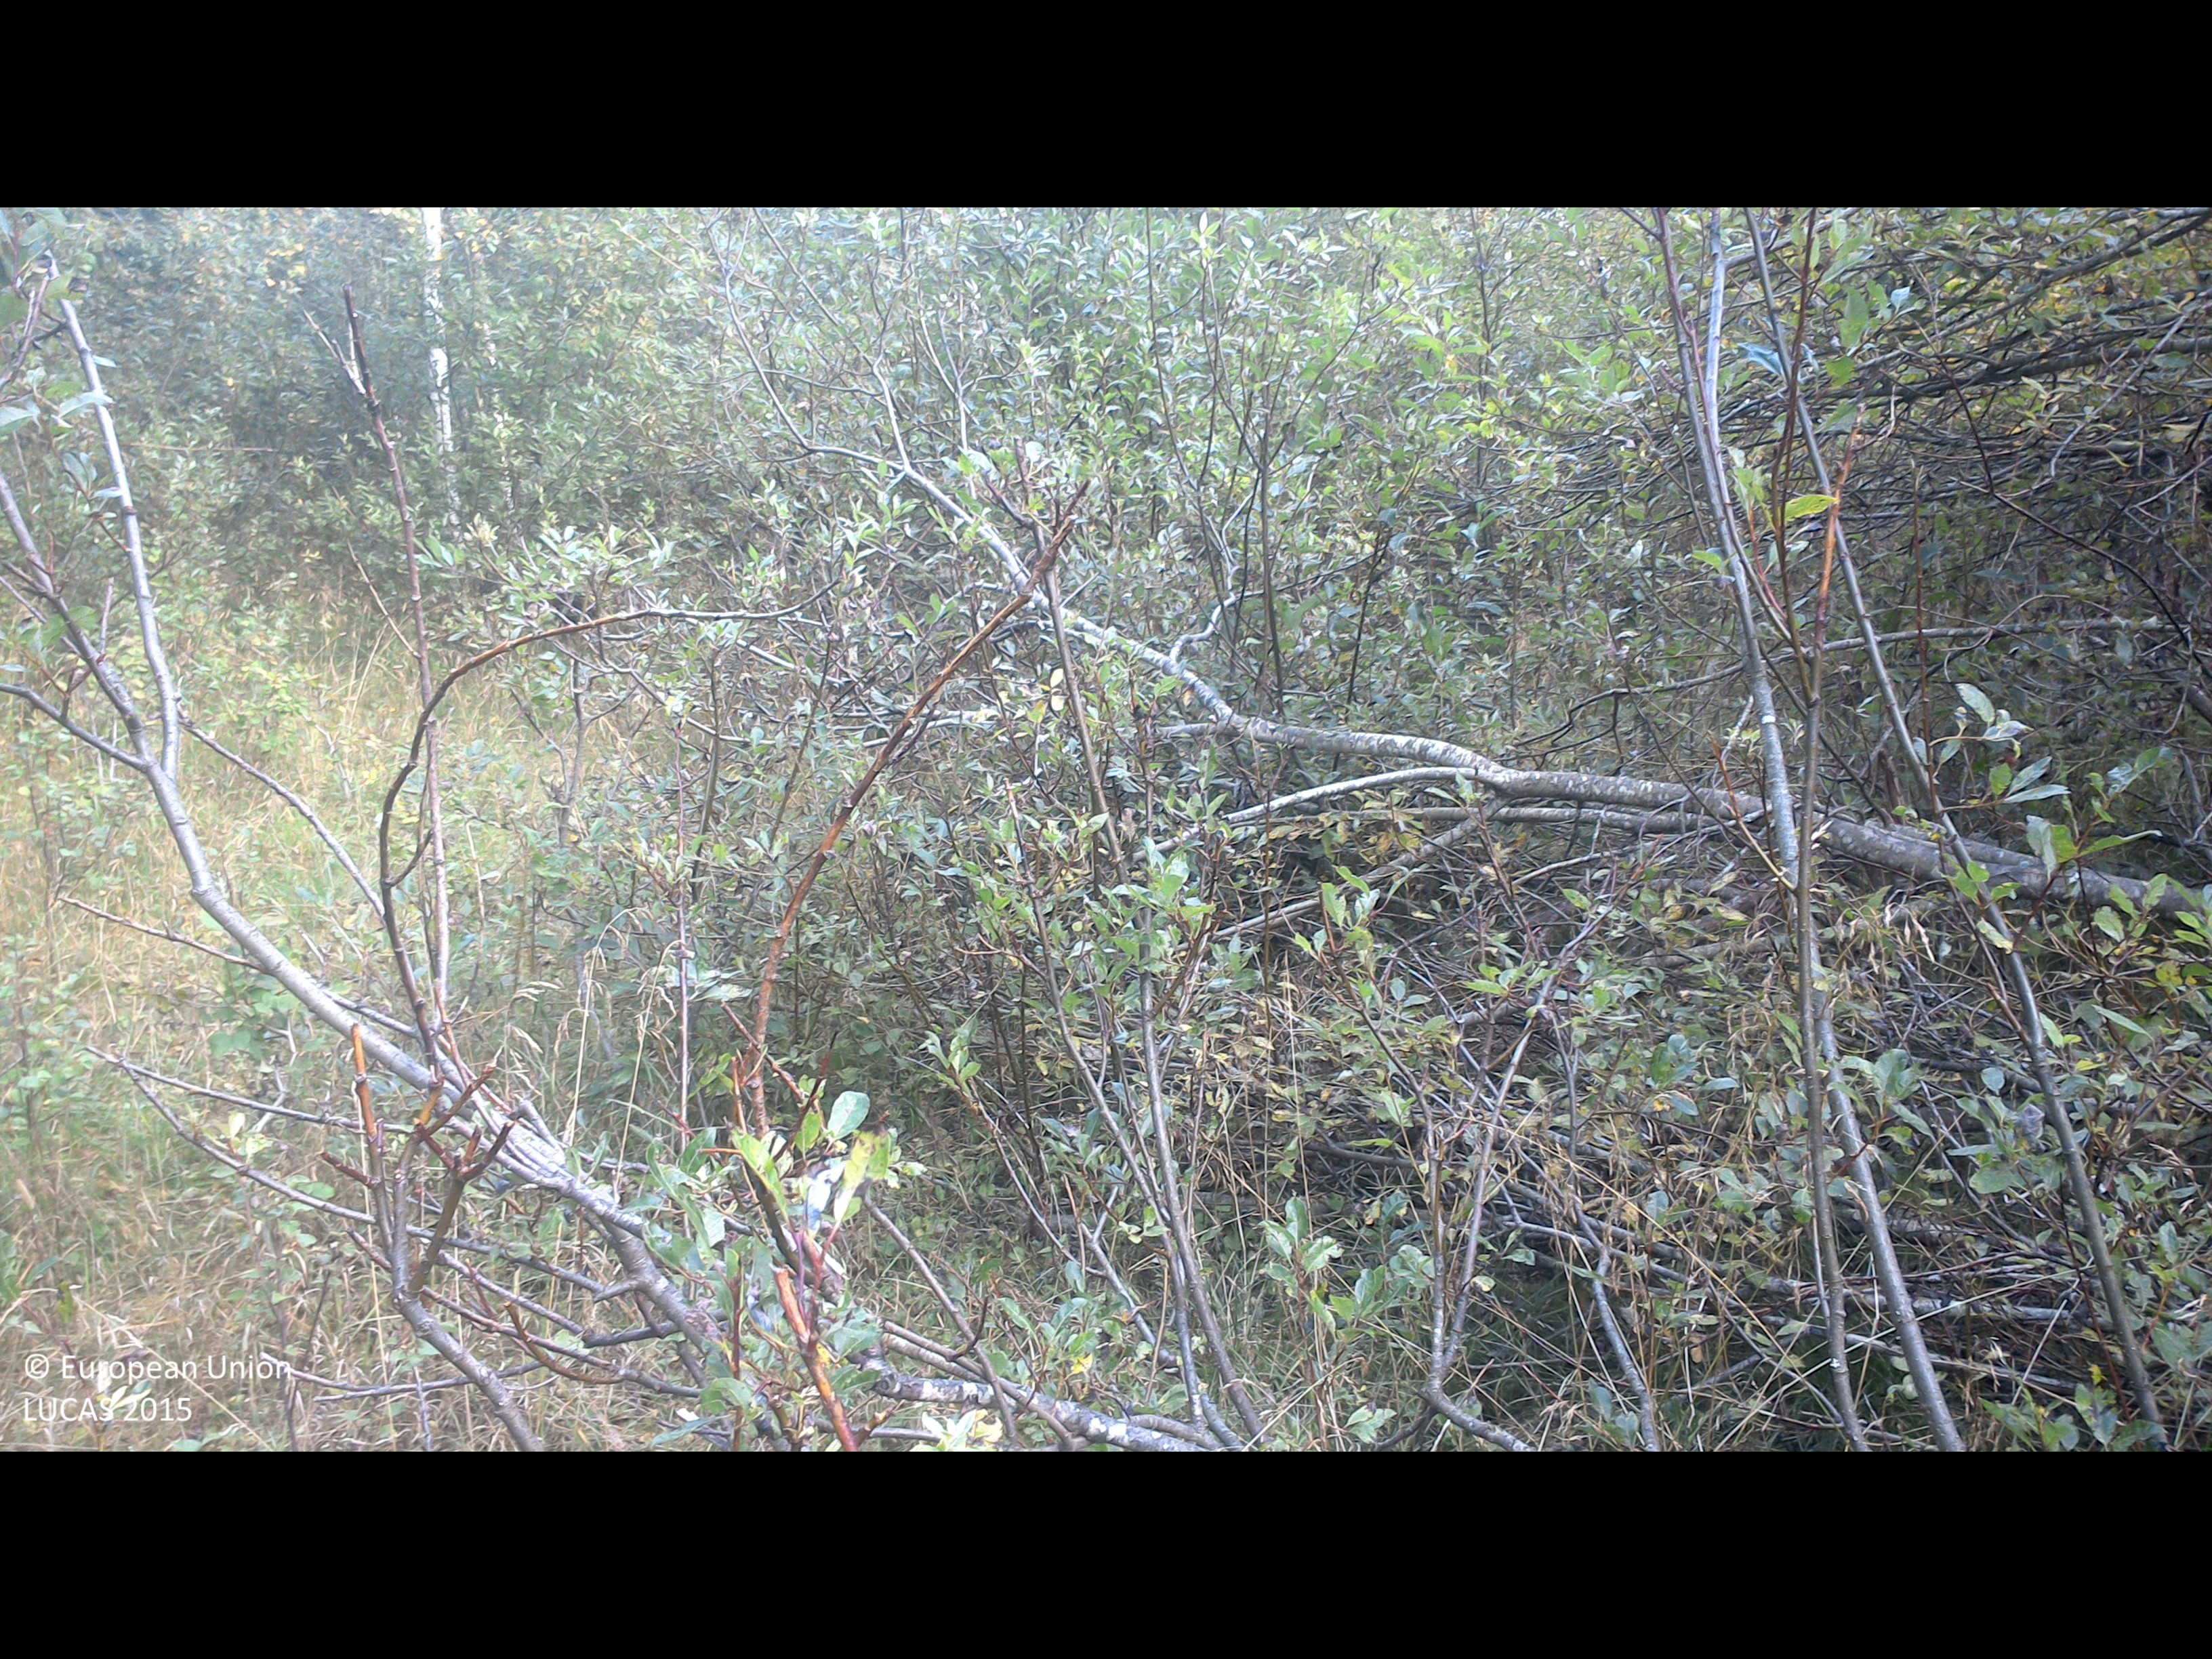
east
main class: Woodland
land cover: Broadleaved woodland
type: boreal forest
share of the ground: 50 - 75 %
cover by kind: broadleaved forest trees 60 %, herbaceous plants 40 %
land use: Semi-natural and natural areas not in use
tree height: > 5 m
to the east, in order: Broadleaved woodland; Ditches and canals; Broadleaved woodland; Grassland without tree/shrub cover; Artificial constructions in urban areas; Spruce dominated mixed woodland
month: September
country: SE
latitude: 63.8034
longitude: 19.4999
